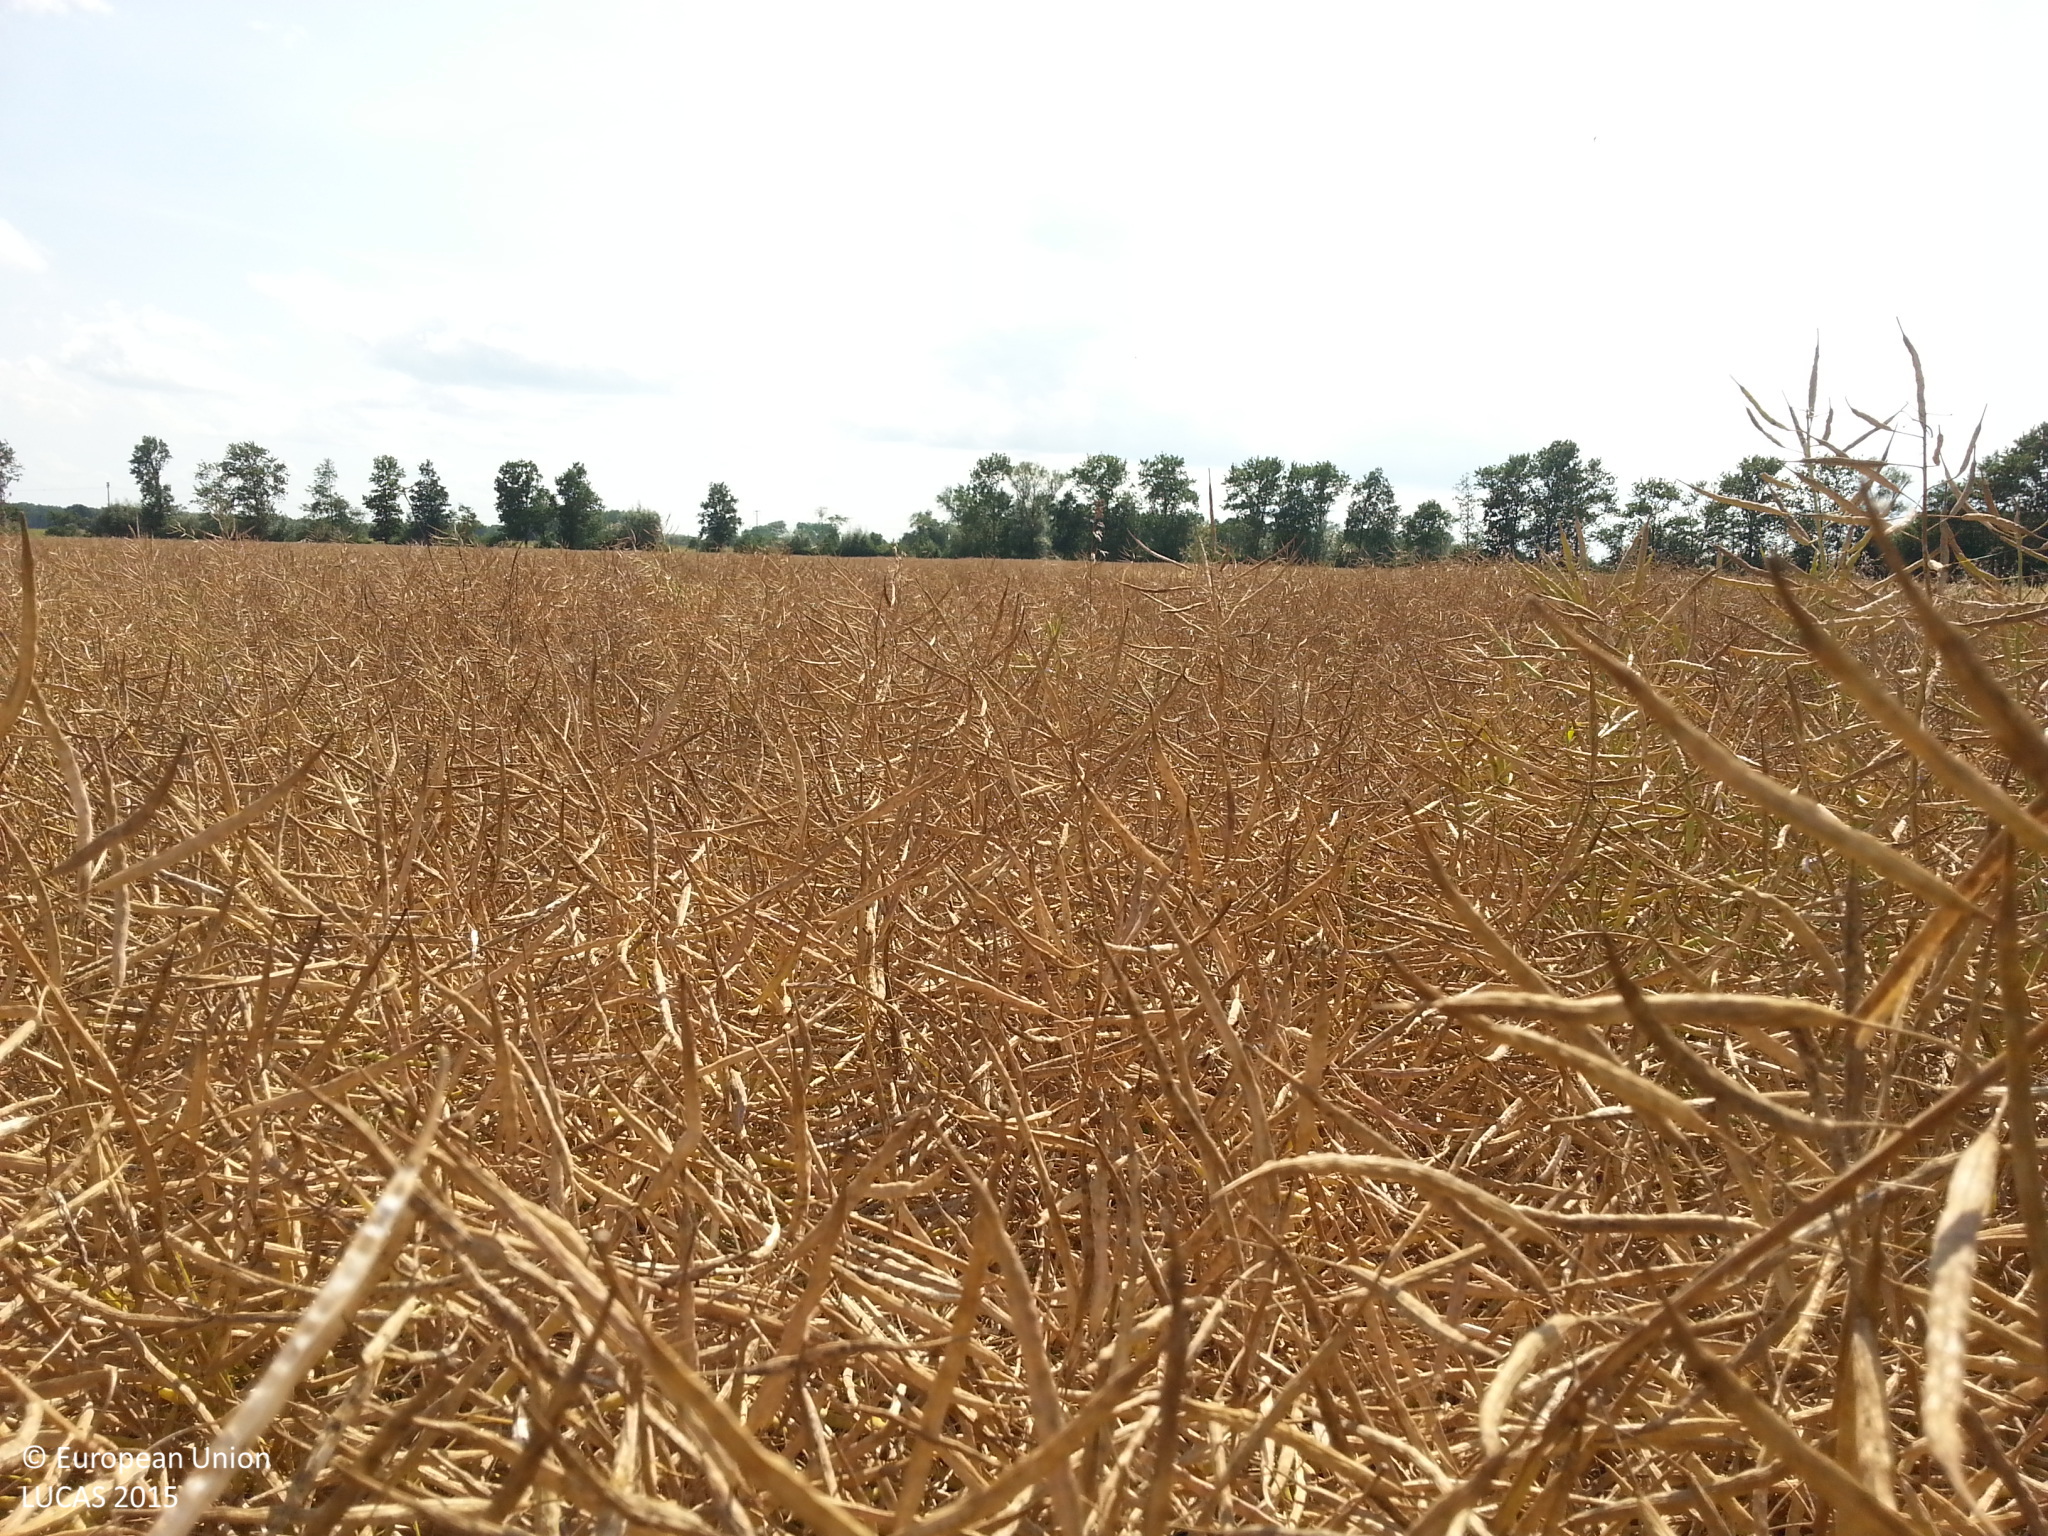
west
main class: Cropland
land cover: Rape and turnip rape
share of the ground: > 75 %
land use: Agriculture (excluding fallow land and kitchen gardens)
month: July
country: DE
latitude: 53.1808
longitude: 11.1517
